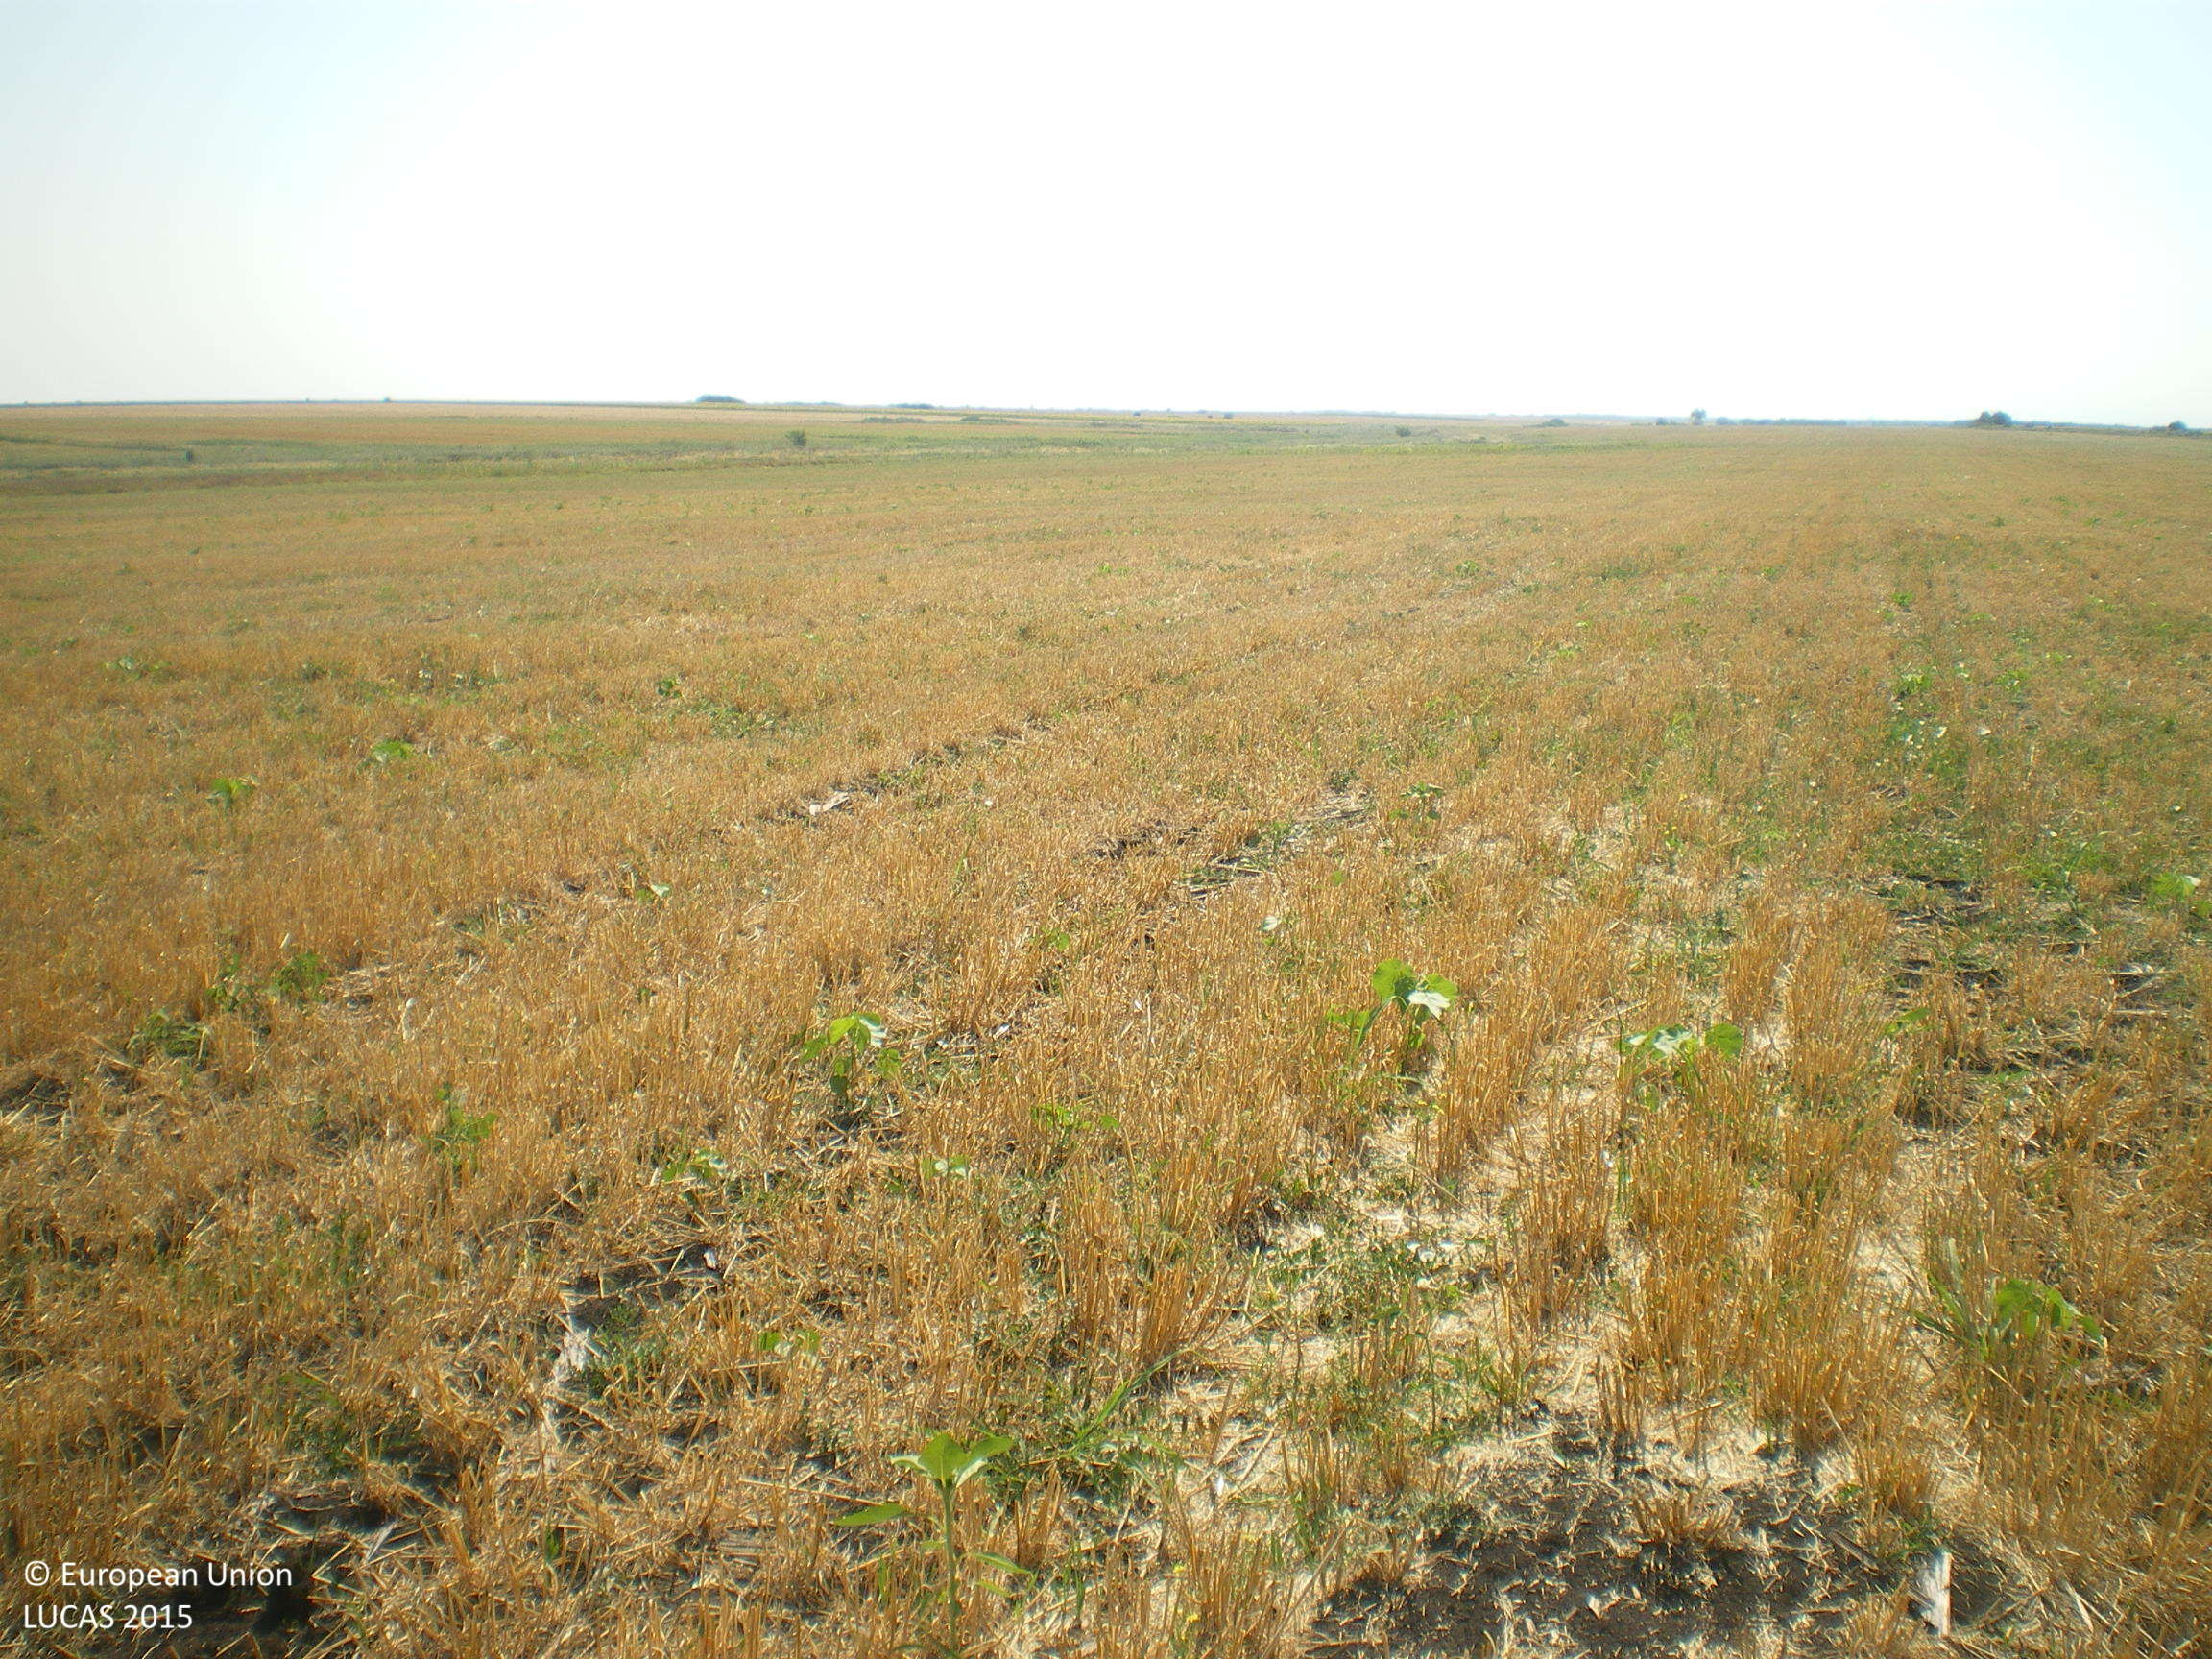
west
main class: Cropland
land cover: Common wheat
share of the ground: 10 - 25 %
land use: Agriculture (excluding fallow land and kitchen gardens)
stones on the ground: < 10 %
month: July
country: BG
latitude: 42.2305
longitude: 25.6891
